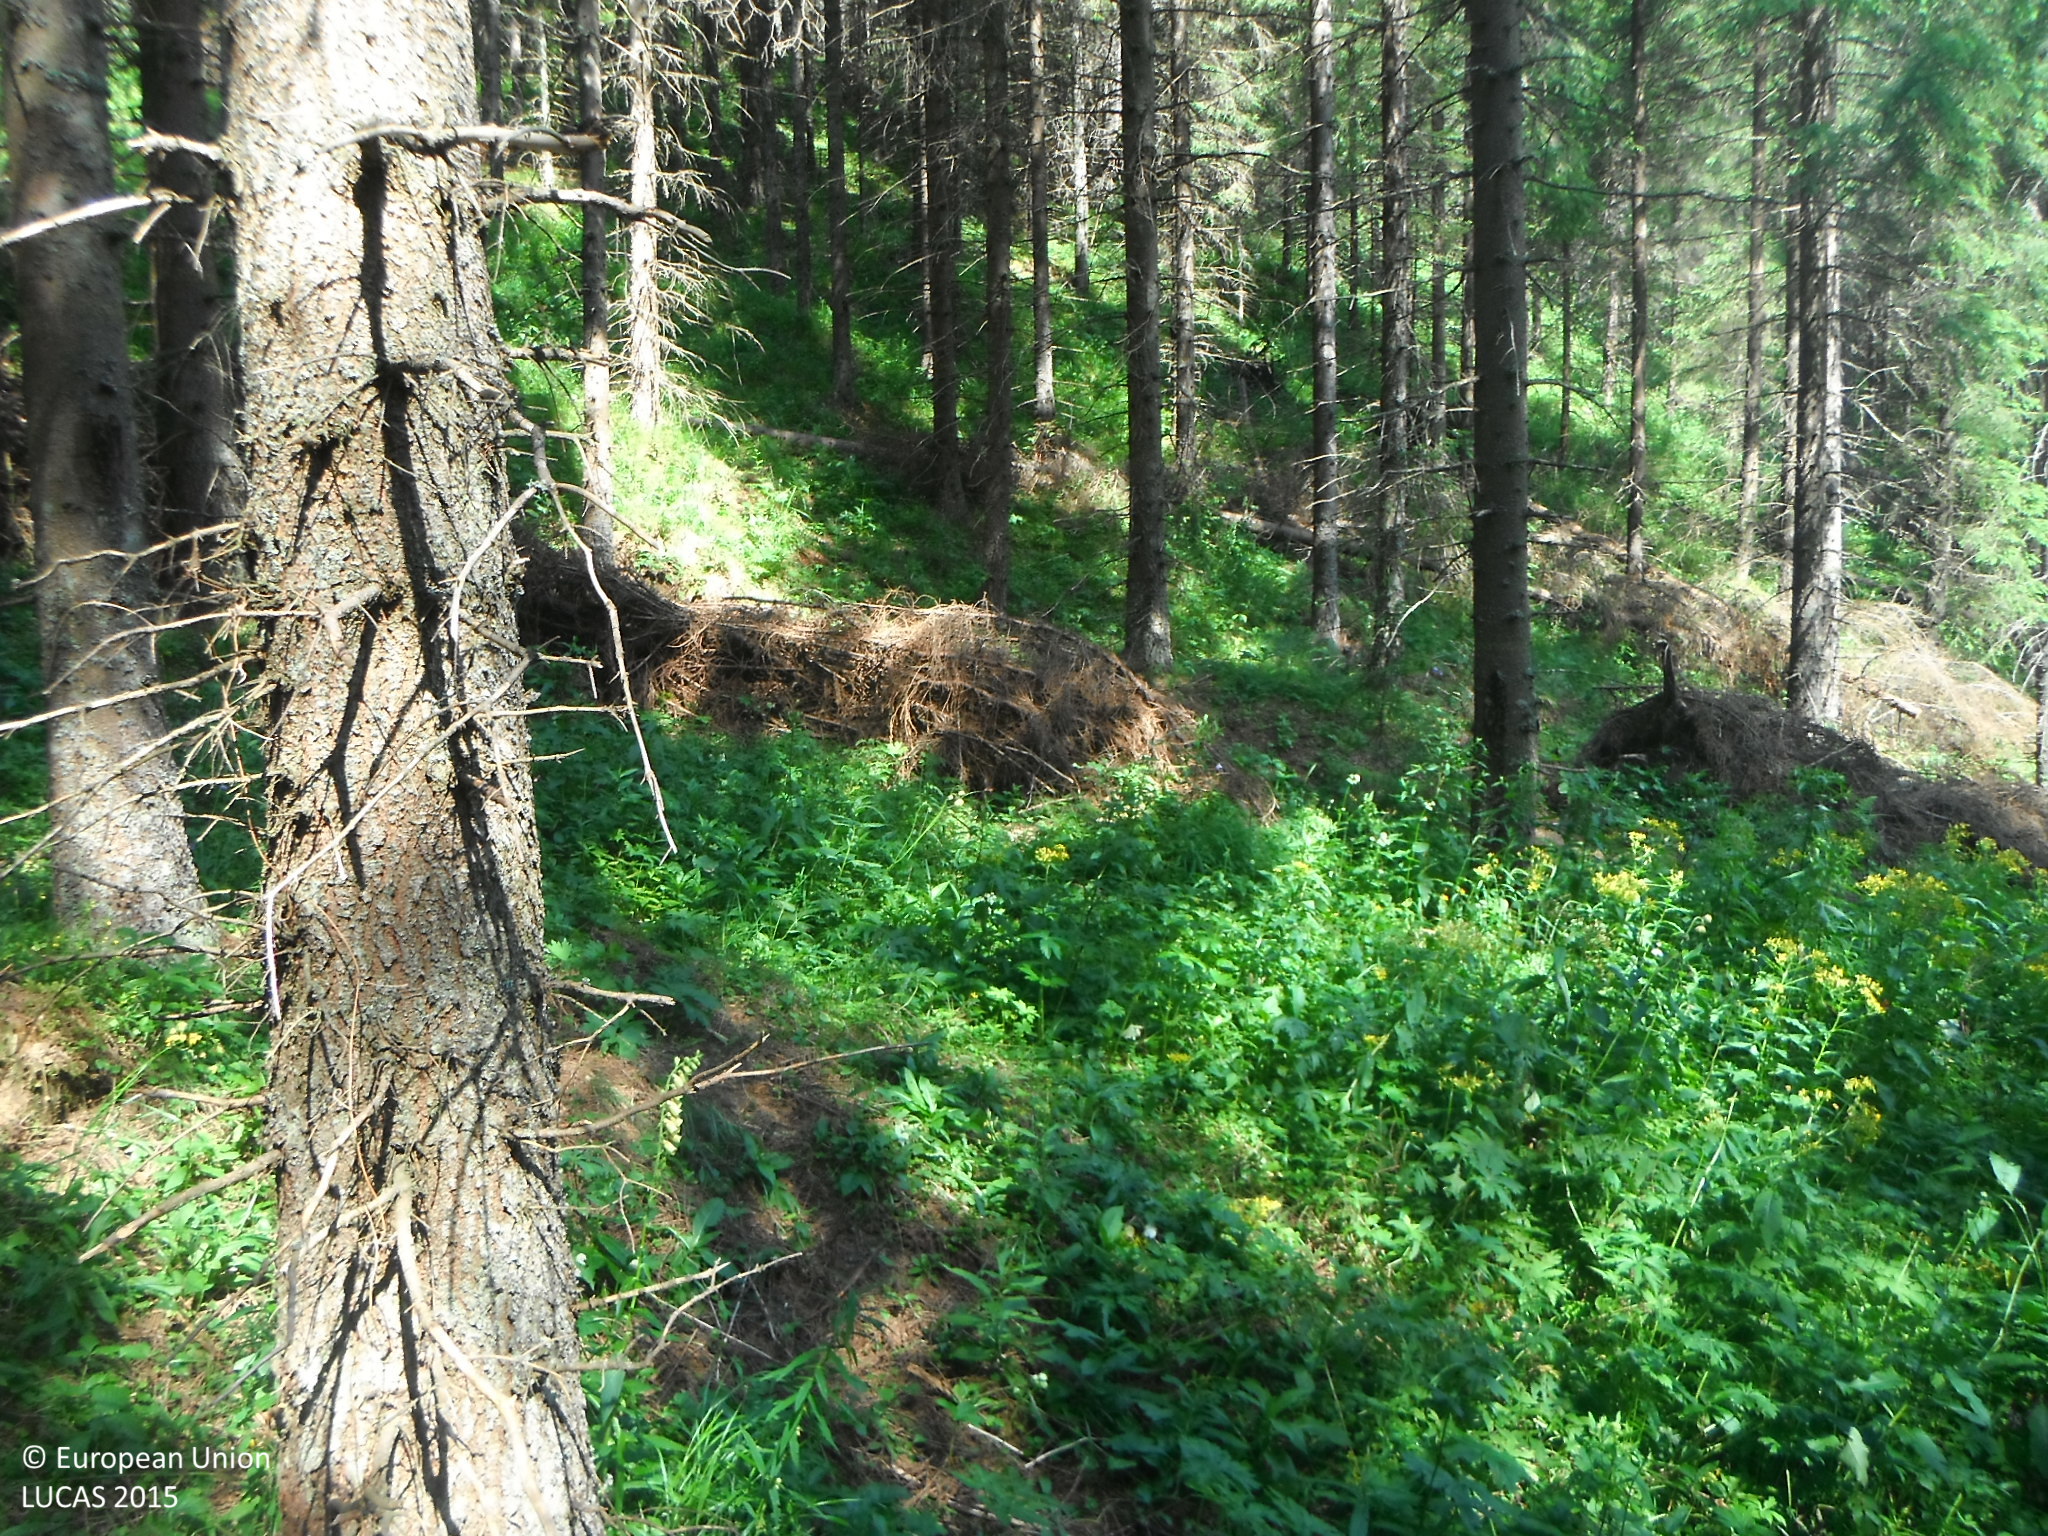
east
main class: Woodland
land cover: Spruce dominated coniferous woodland
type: alpine coniferous forest
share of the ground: > 75 %
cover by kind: coniferous forest trees 100 %
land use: Forestry
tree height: > 5 m
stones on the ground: > 50 %
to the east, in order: Spruce dominated coniferous woodland; Tracks; Spruce dominated coniferous woodland; Spontaneously vegetated surfaces; Spruce dominated coniferous woodland; Tracks; Spruce dominated coniferous woodland; Tracks; Spruce dominated coniferous woodland
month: July
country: SK
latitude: 49.2861
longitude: 20.2486
